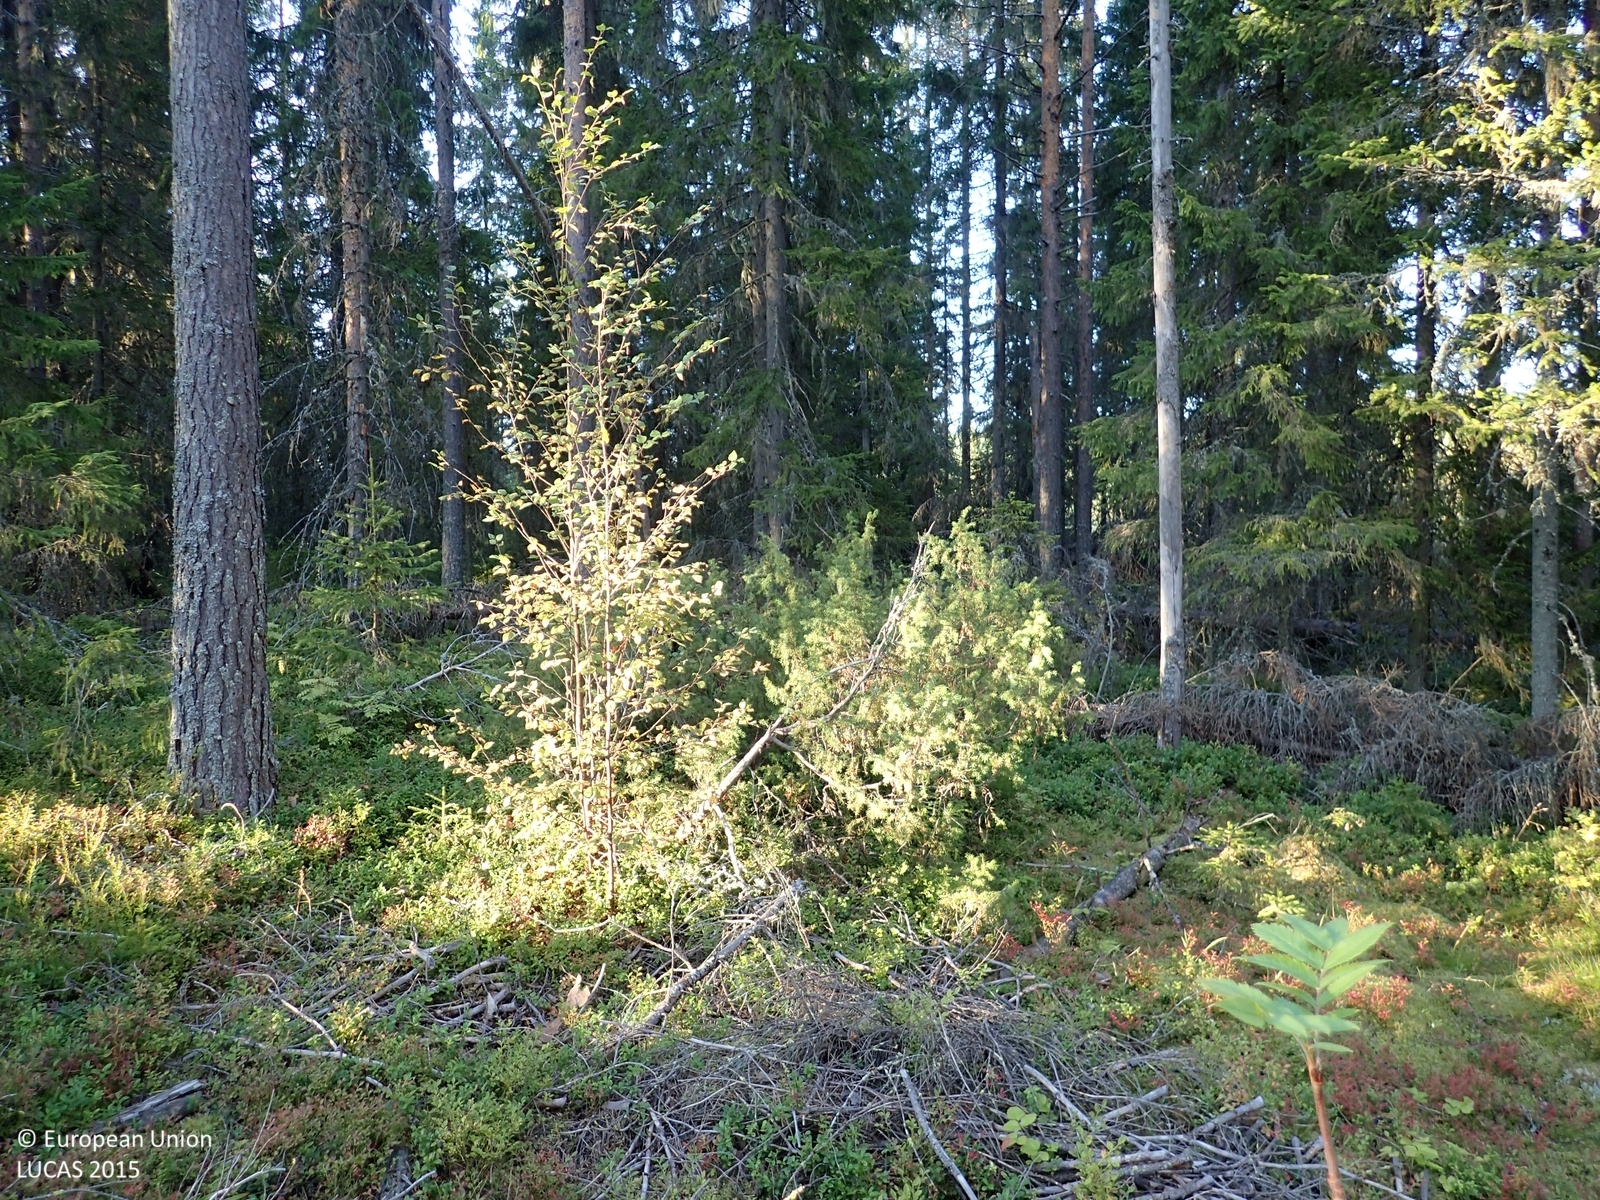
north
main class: Woodland
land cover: Other coniferous woodland
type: boreal forest
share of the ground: > 75 %
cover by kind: coniferous forest trees 75 %, shrubs 20 %, lichens and mosses 5 %
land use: Forestry
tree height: > 5 m
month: September
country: FI
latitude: 62.9091
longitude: 25.6808
